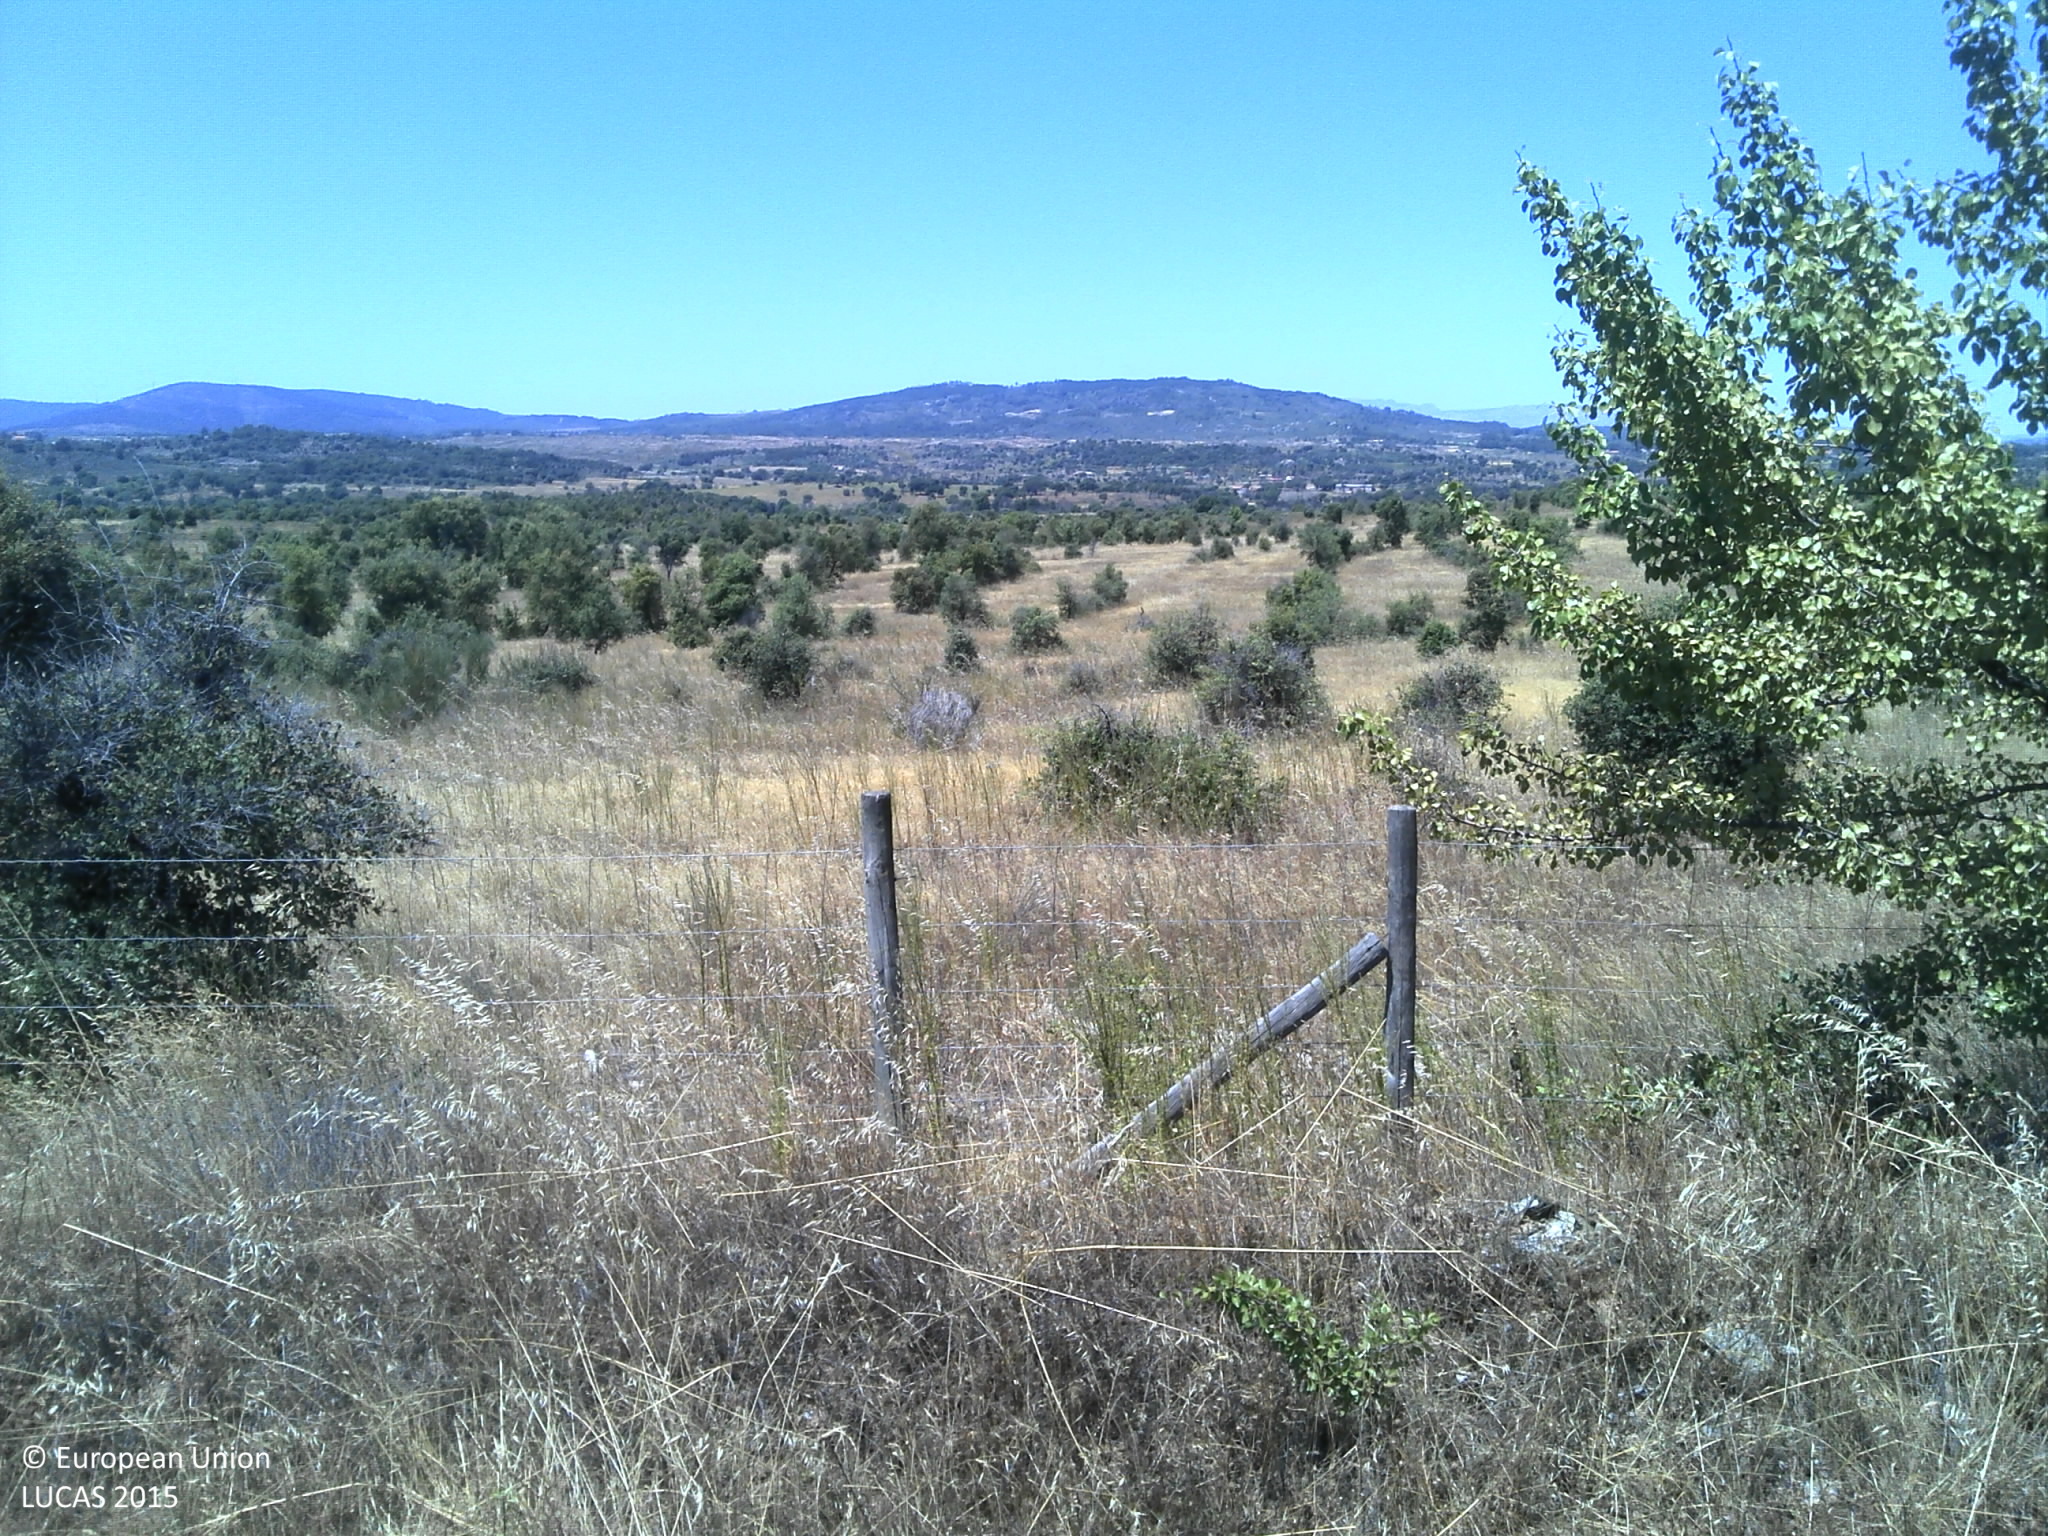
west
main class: Woodland
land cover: Broadleaved woodland
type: broadleaved evergreen forest
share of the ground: 10 - 25 %
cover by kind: unconsolidated bare surface 35 %, broadleaved forest trees 25 %, shrubs 20 %, herbaceous plants 20 %
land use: Forestry
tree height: < 5 m
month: June
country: PT
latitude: 40.1037
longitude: -7.2849
